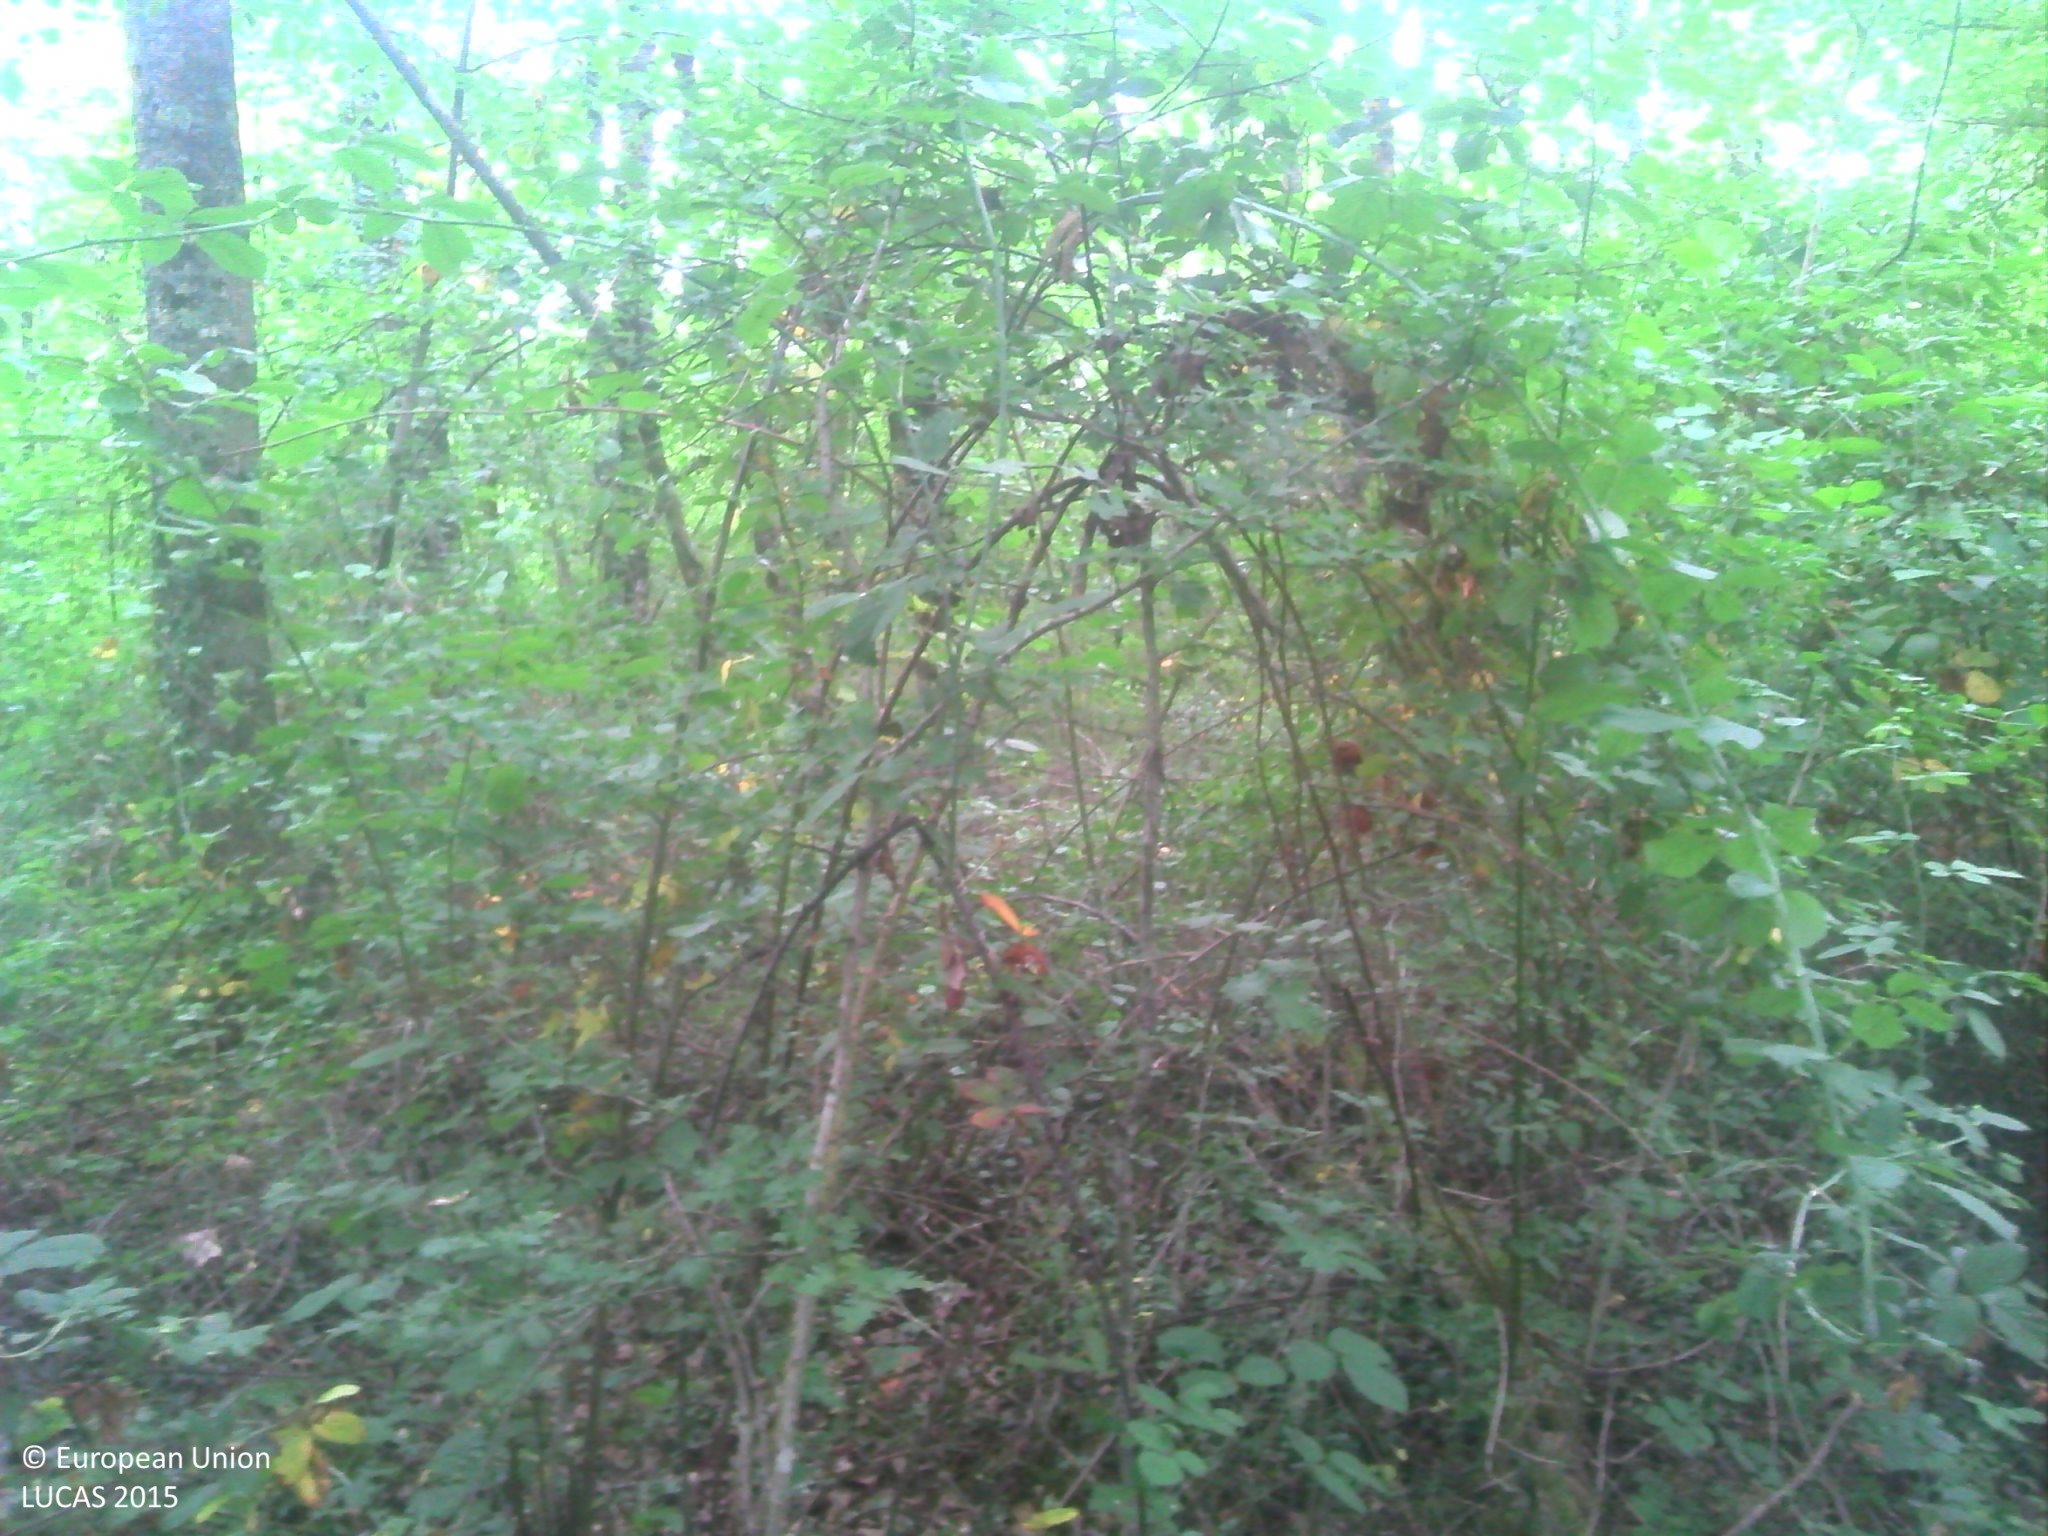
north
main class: Woodland
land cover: Broadleaved woodland
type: acidophilous oak and oak-birch forest
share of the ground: > 75 %
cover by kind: broadleaved forest trees 60 %, shrubs 30 %, herbaceous plants 10 %
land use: Forestry
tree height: > 5 m
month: July
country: FR
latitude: 43.2910
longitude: 1.4632
